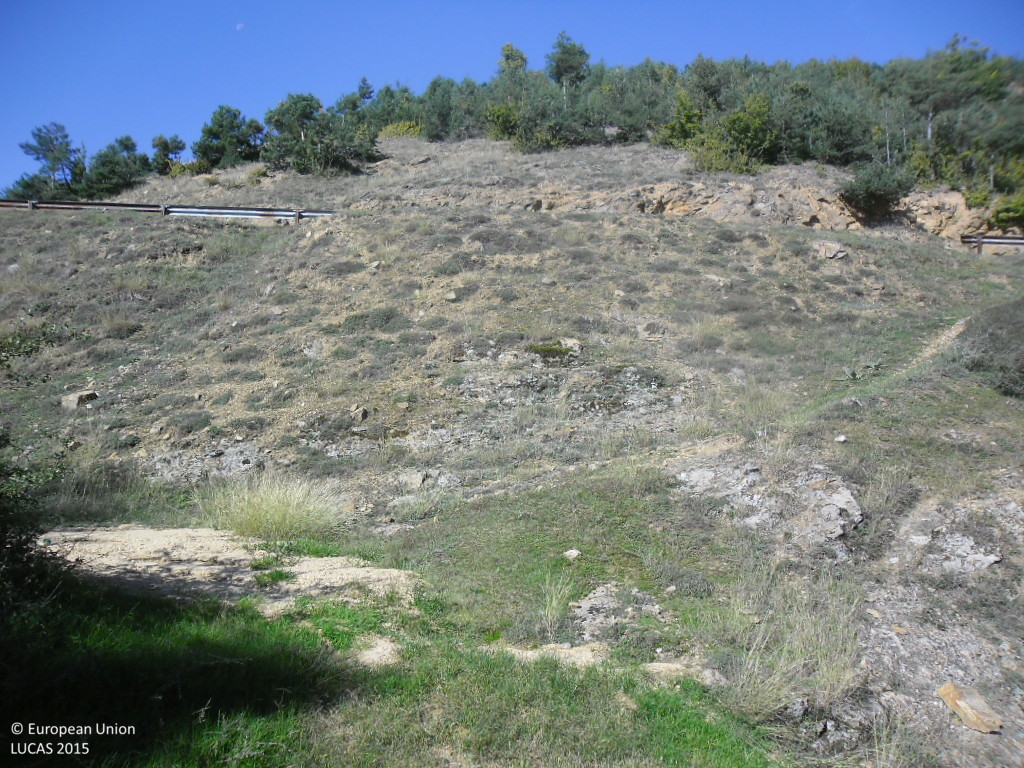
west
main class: Grassland
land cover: Grassland with sparse tree/shrub cover
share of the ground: > 75 %
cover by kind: herbaceous plants 90 %, broadleaved forest trees 5 %, shrubs 5 %
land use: Agriculture (excluding fallow land and kitchen gardens)
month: October
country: BG
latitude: 41.4463
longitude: 23.0040
